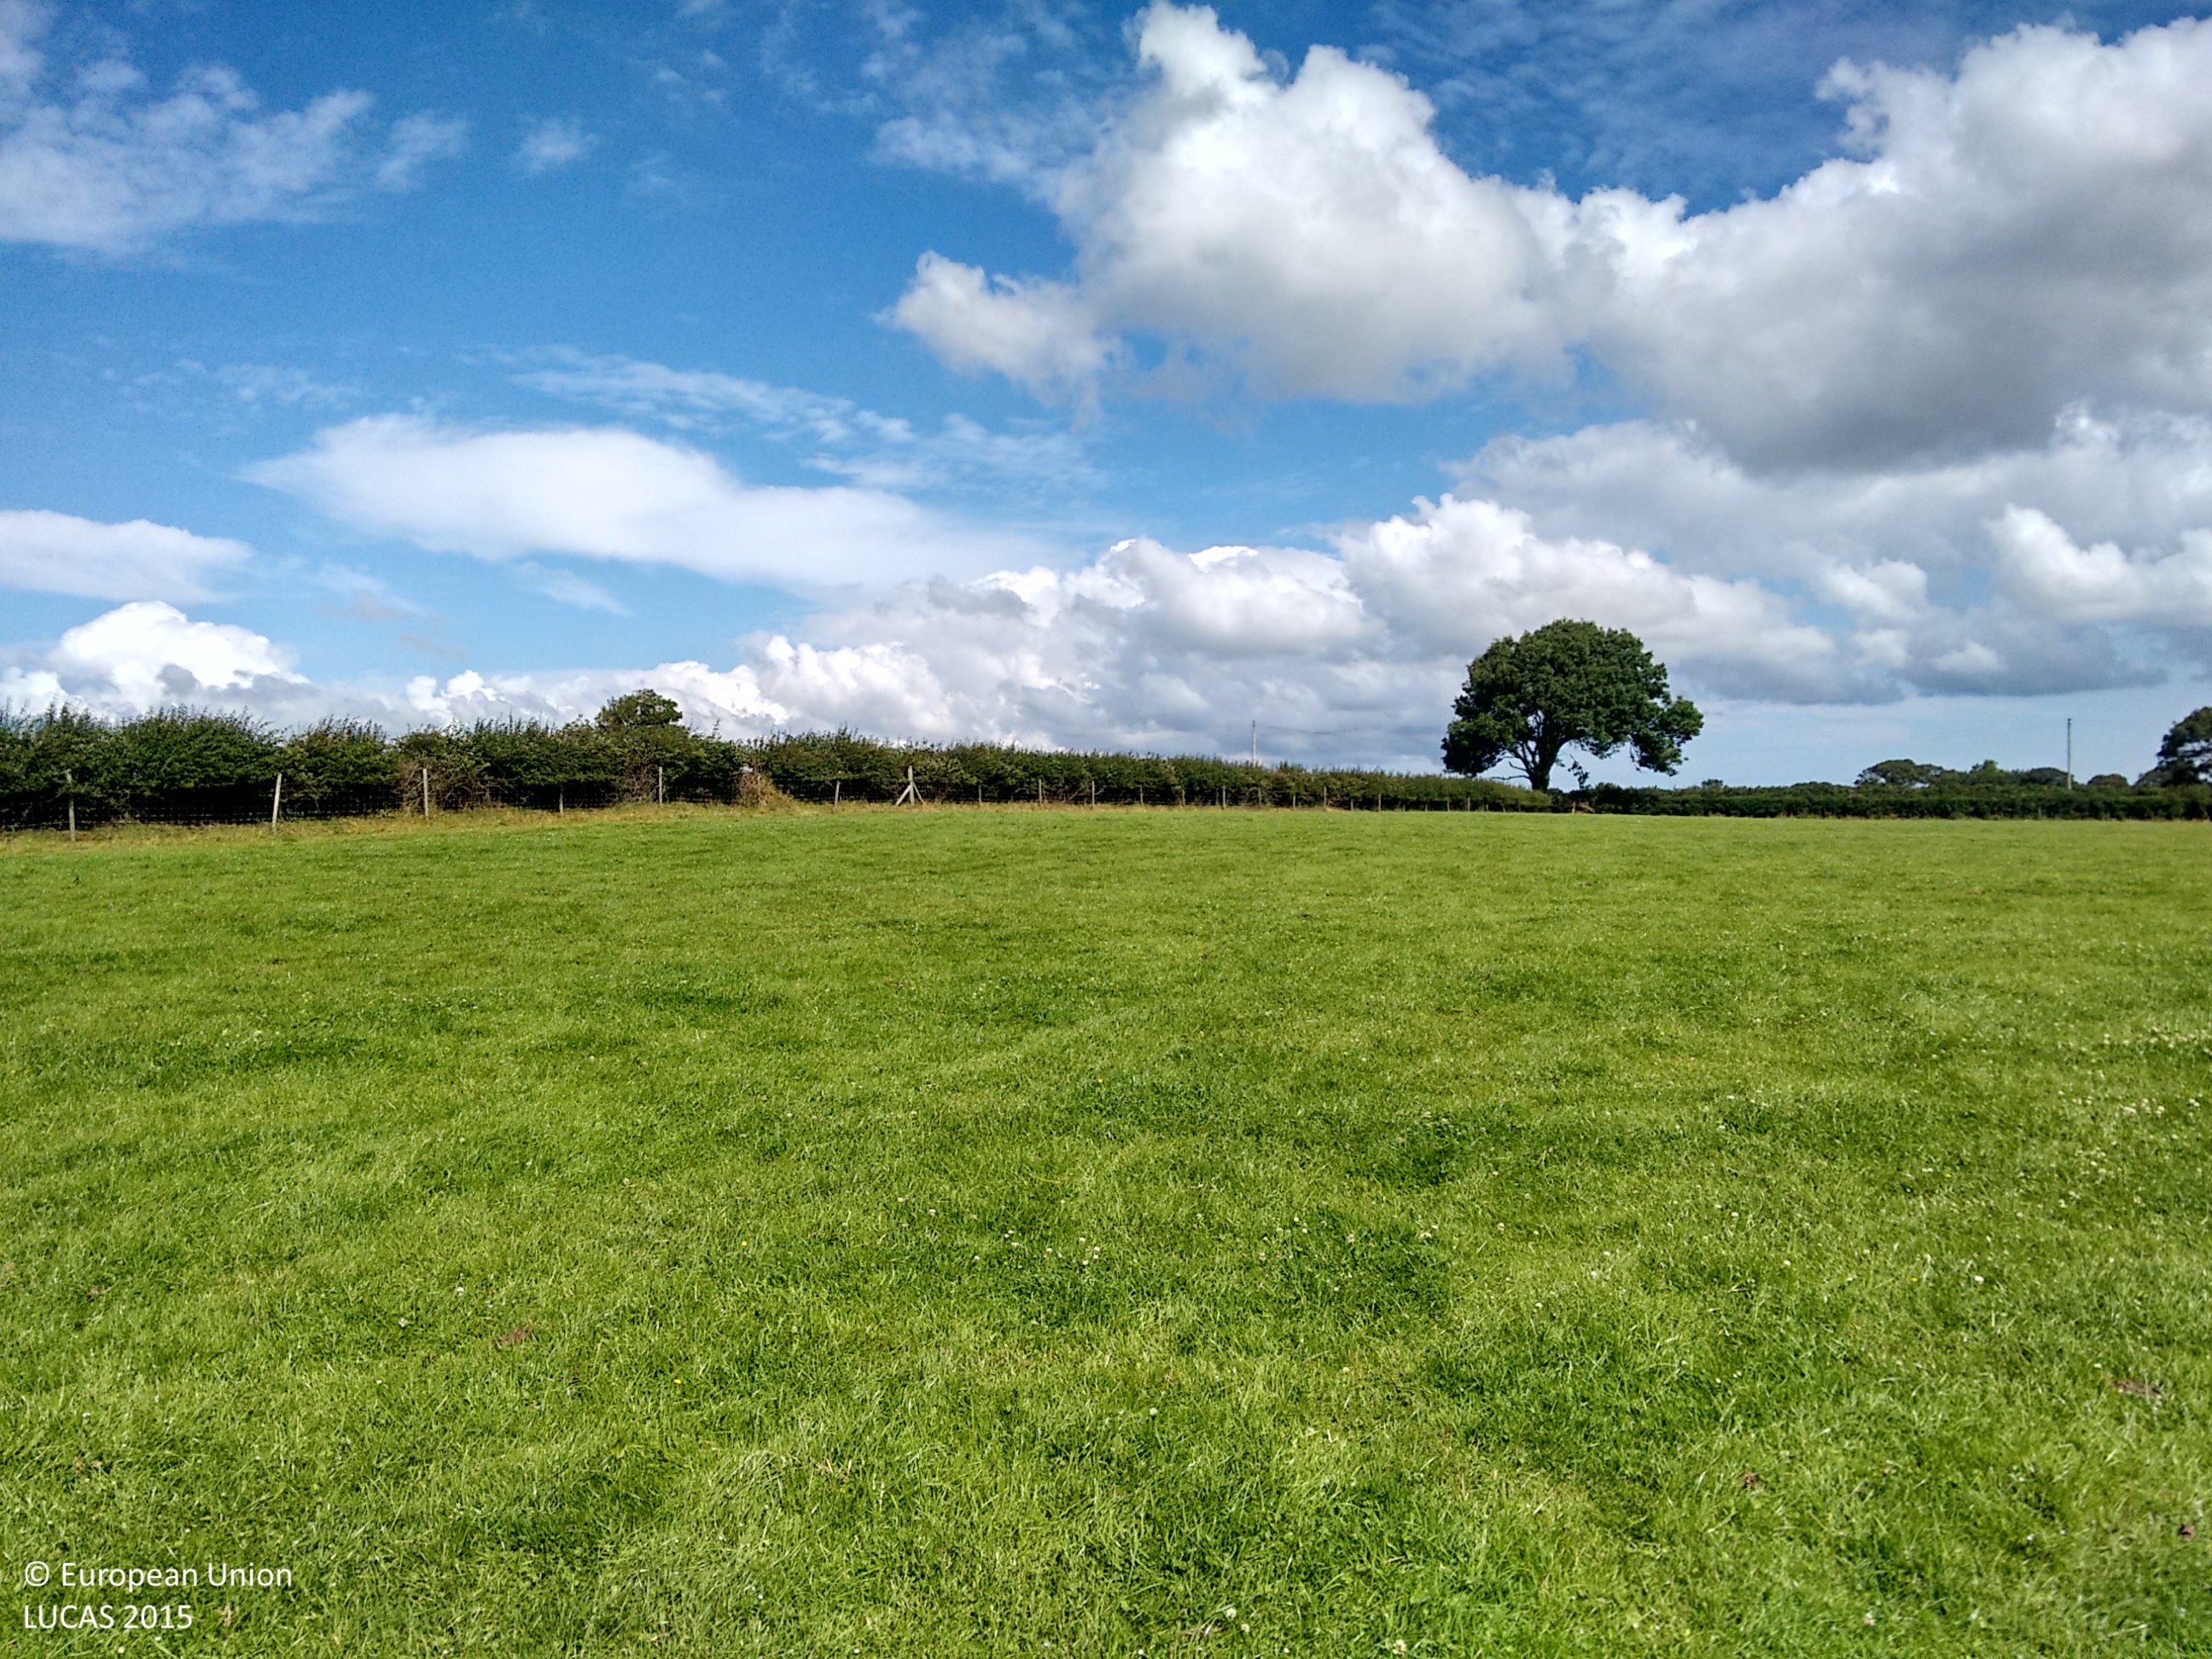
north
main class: Grassland
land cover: Grassland without tree/shrub cover
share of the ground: > 75 %
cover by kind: herbaceous plants 100 %
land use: Agriculture (excluding fallow land and kitchen gardens)
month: August
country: GB
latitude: 53.1865
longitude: -4.3026
